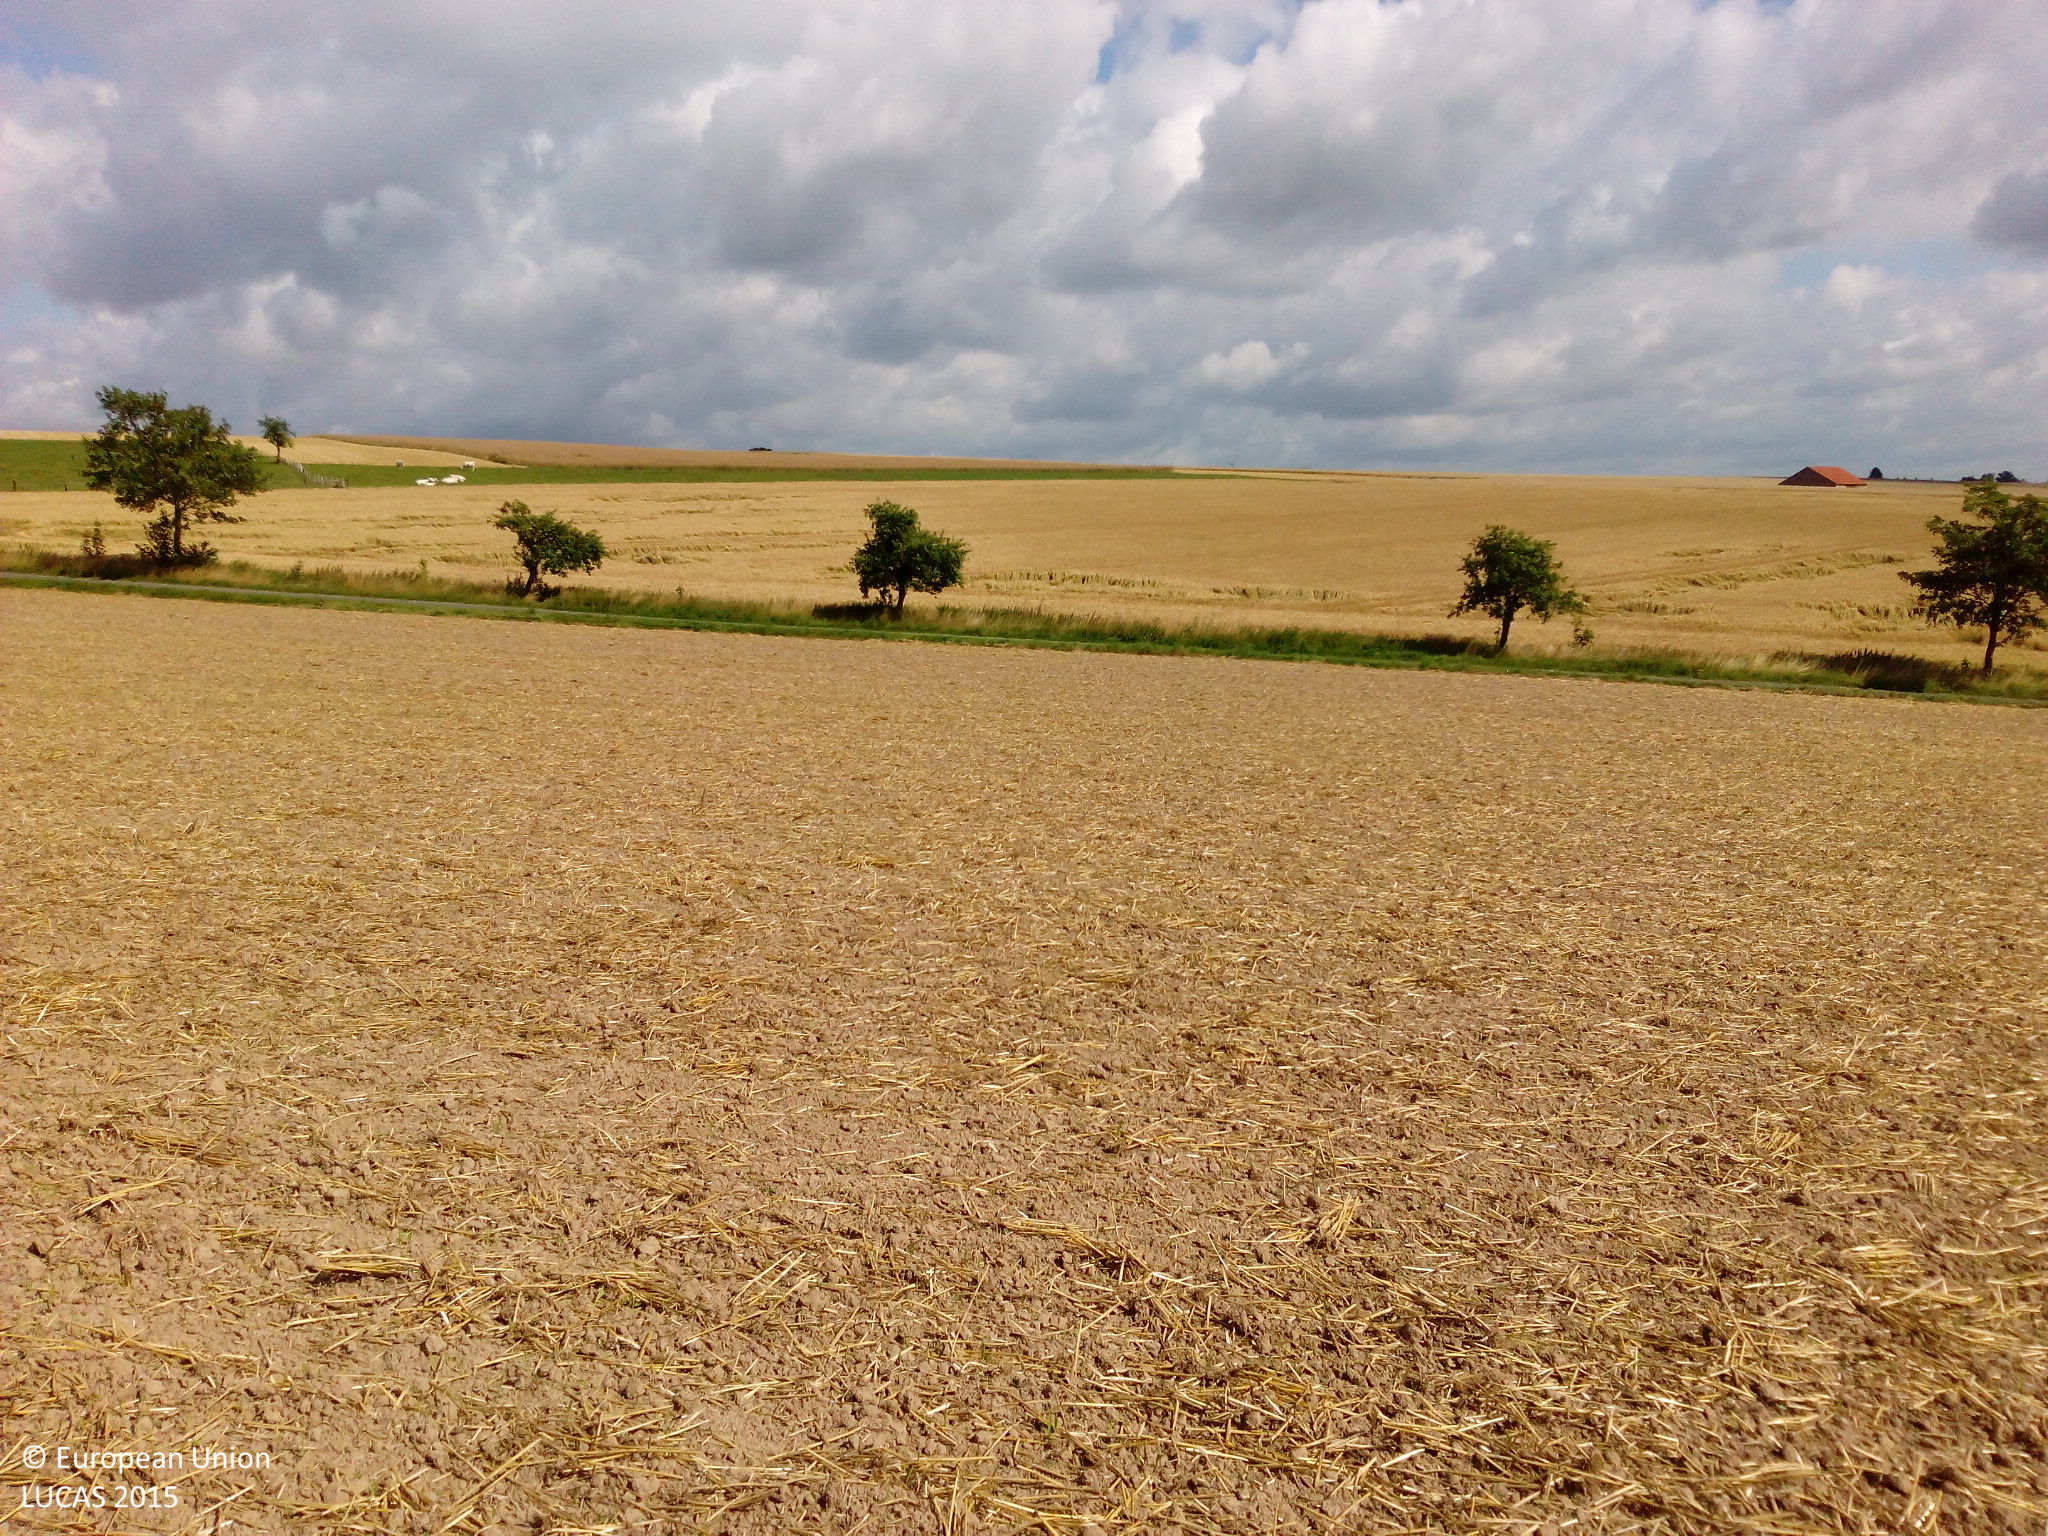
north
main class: Cropland
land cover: Rye
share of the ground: 10 - 25 %
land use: Agriculture (excluding fallow land and kitchen gardens)
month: July
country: DE
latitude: 51.5848
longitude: 9.3507
